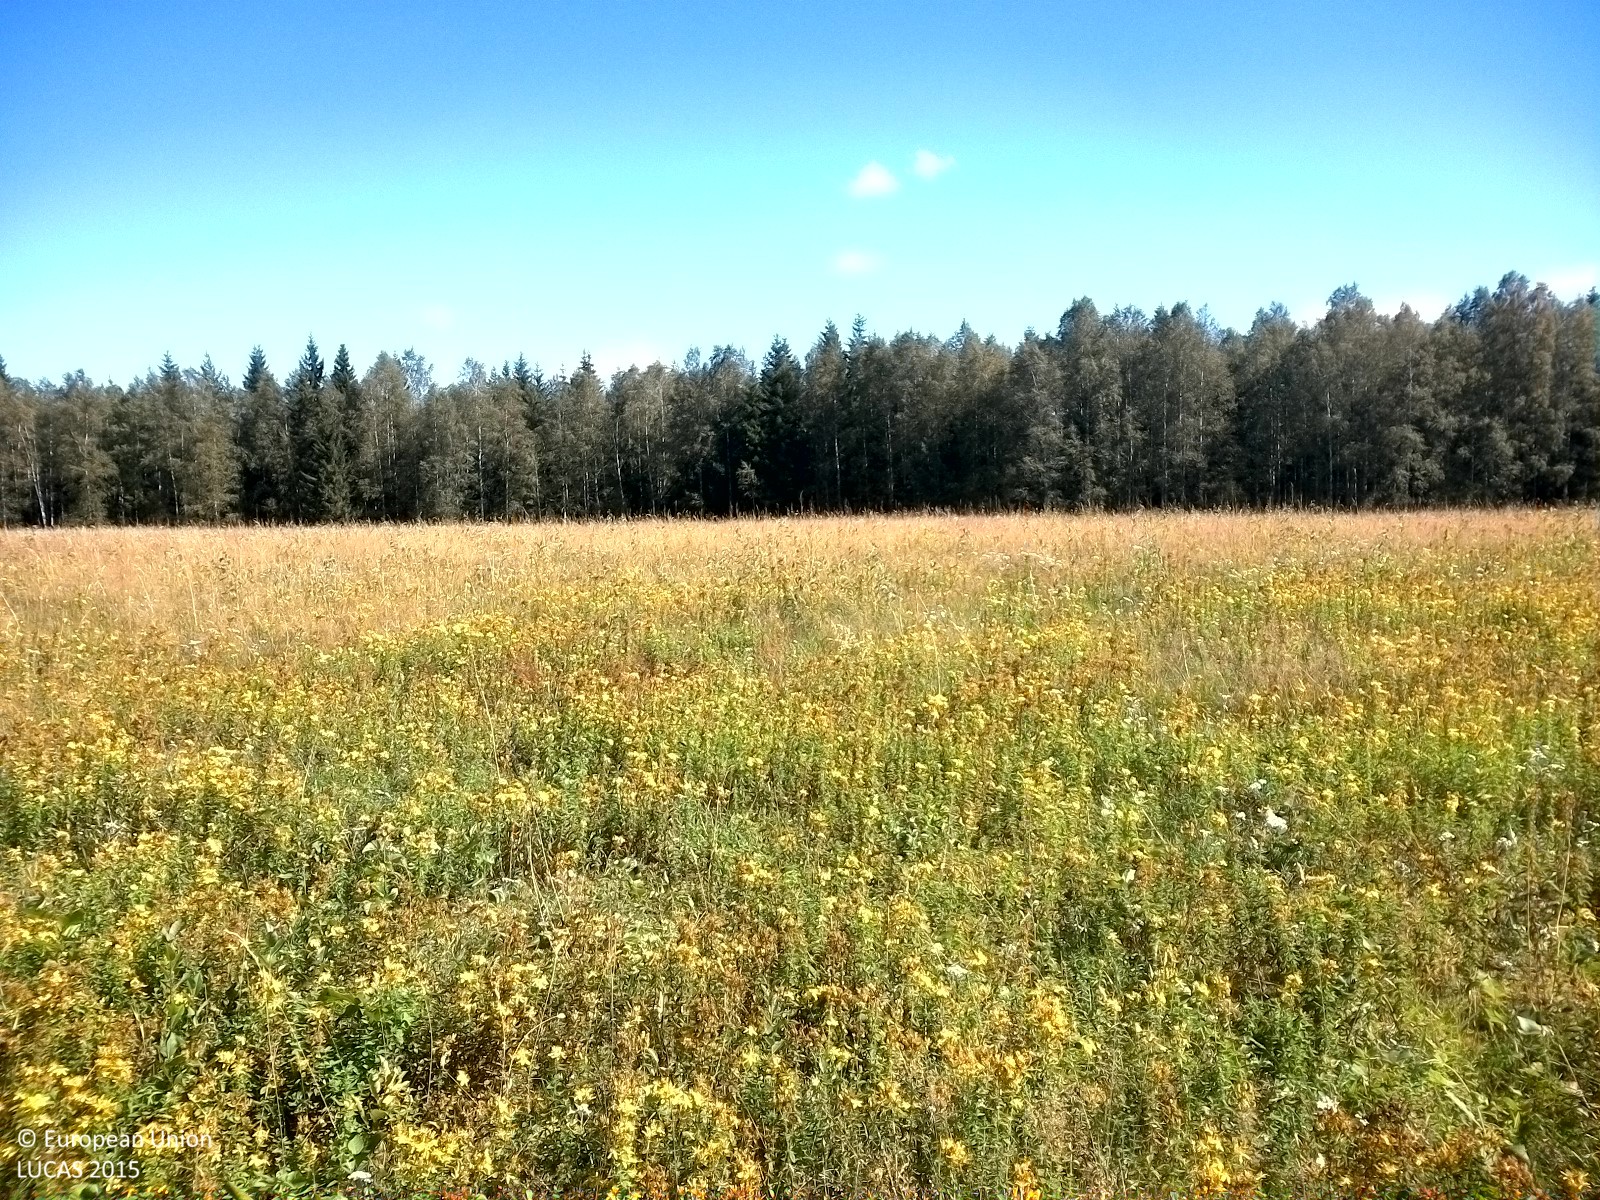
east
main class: Grassland
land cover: Grassland without tree/shrub cover
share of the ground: > 75 %
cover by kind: herbaceous plants 100 %
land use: Semi-natural and natural areas not in use
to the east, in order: Grassland without tree/shrub cover; Ditches and canals; Spruce dominated mixed woodland; Grass margins; Paved roads, cycling and walking lanes; Grass margins; Ditches and canals; Pine dominated mixed woodland
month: August
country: SE
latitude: 59.3982
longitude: 14.7286
